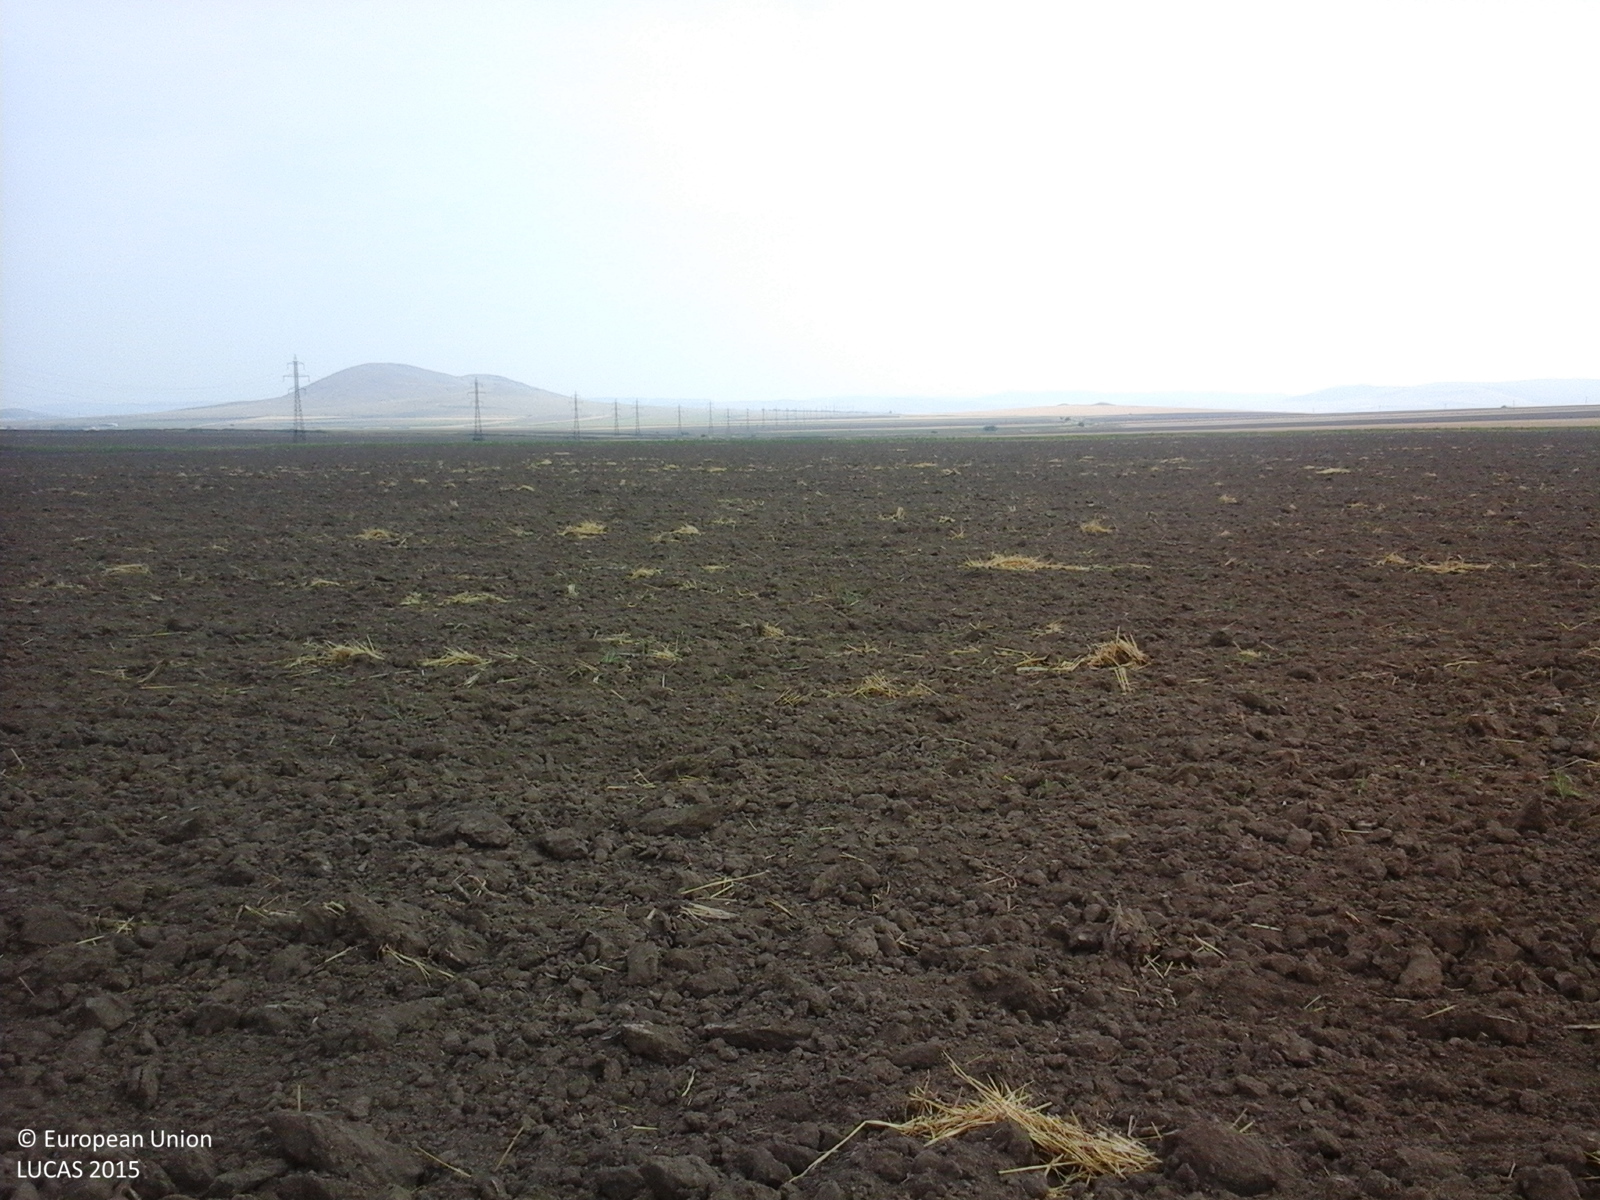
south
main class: Cropland
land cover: Common wheat
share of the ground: < 10 %
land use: Agriculture (excluding fallow land and kitchen gardens)
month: July
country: RO
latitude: 45.0589
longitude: 28.6626
